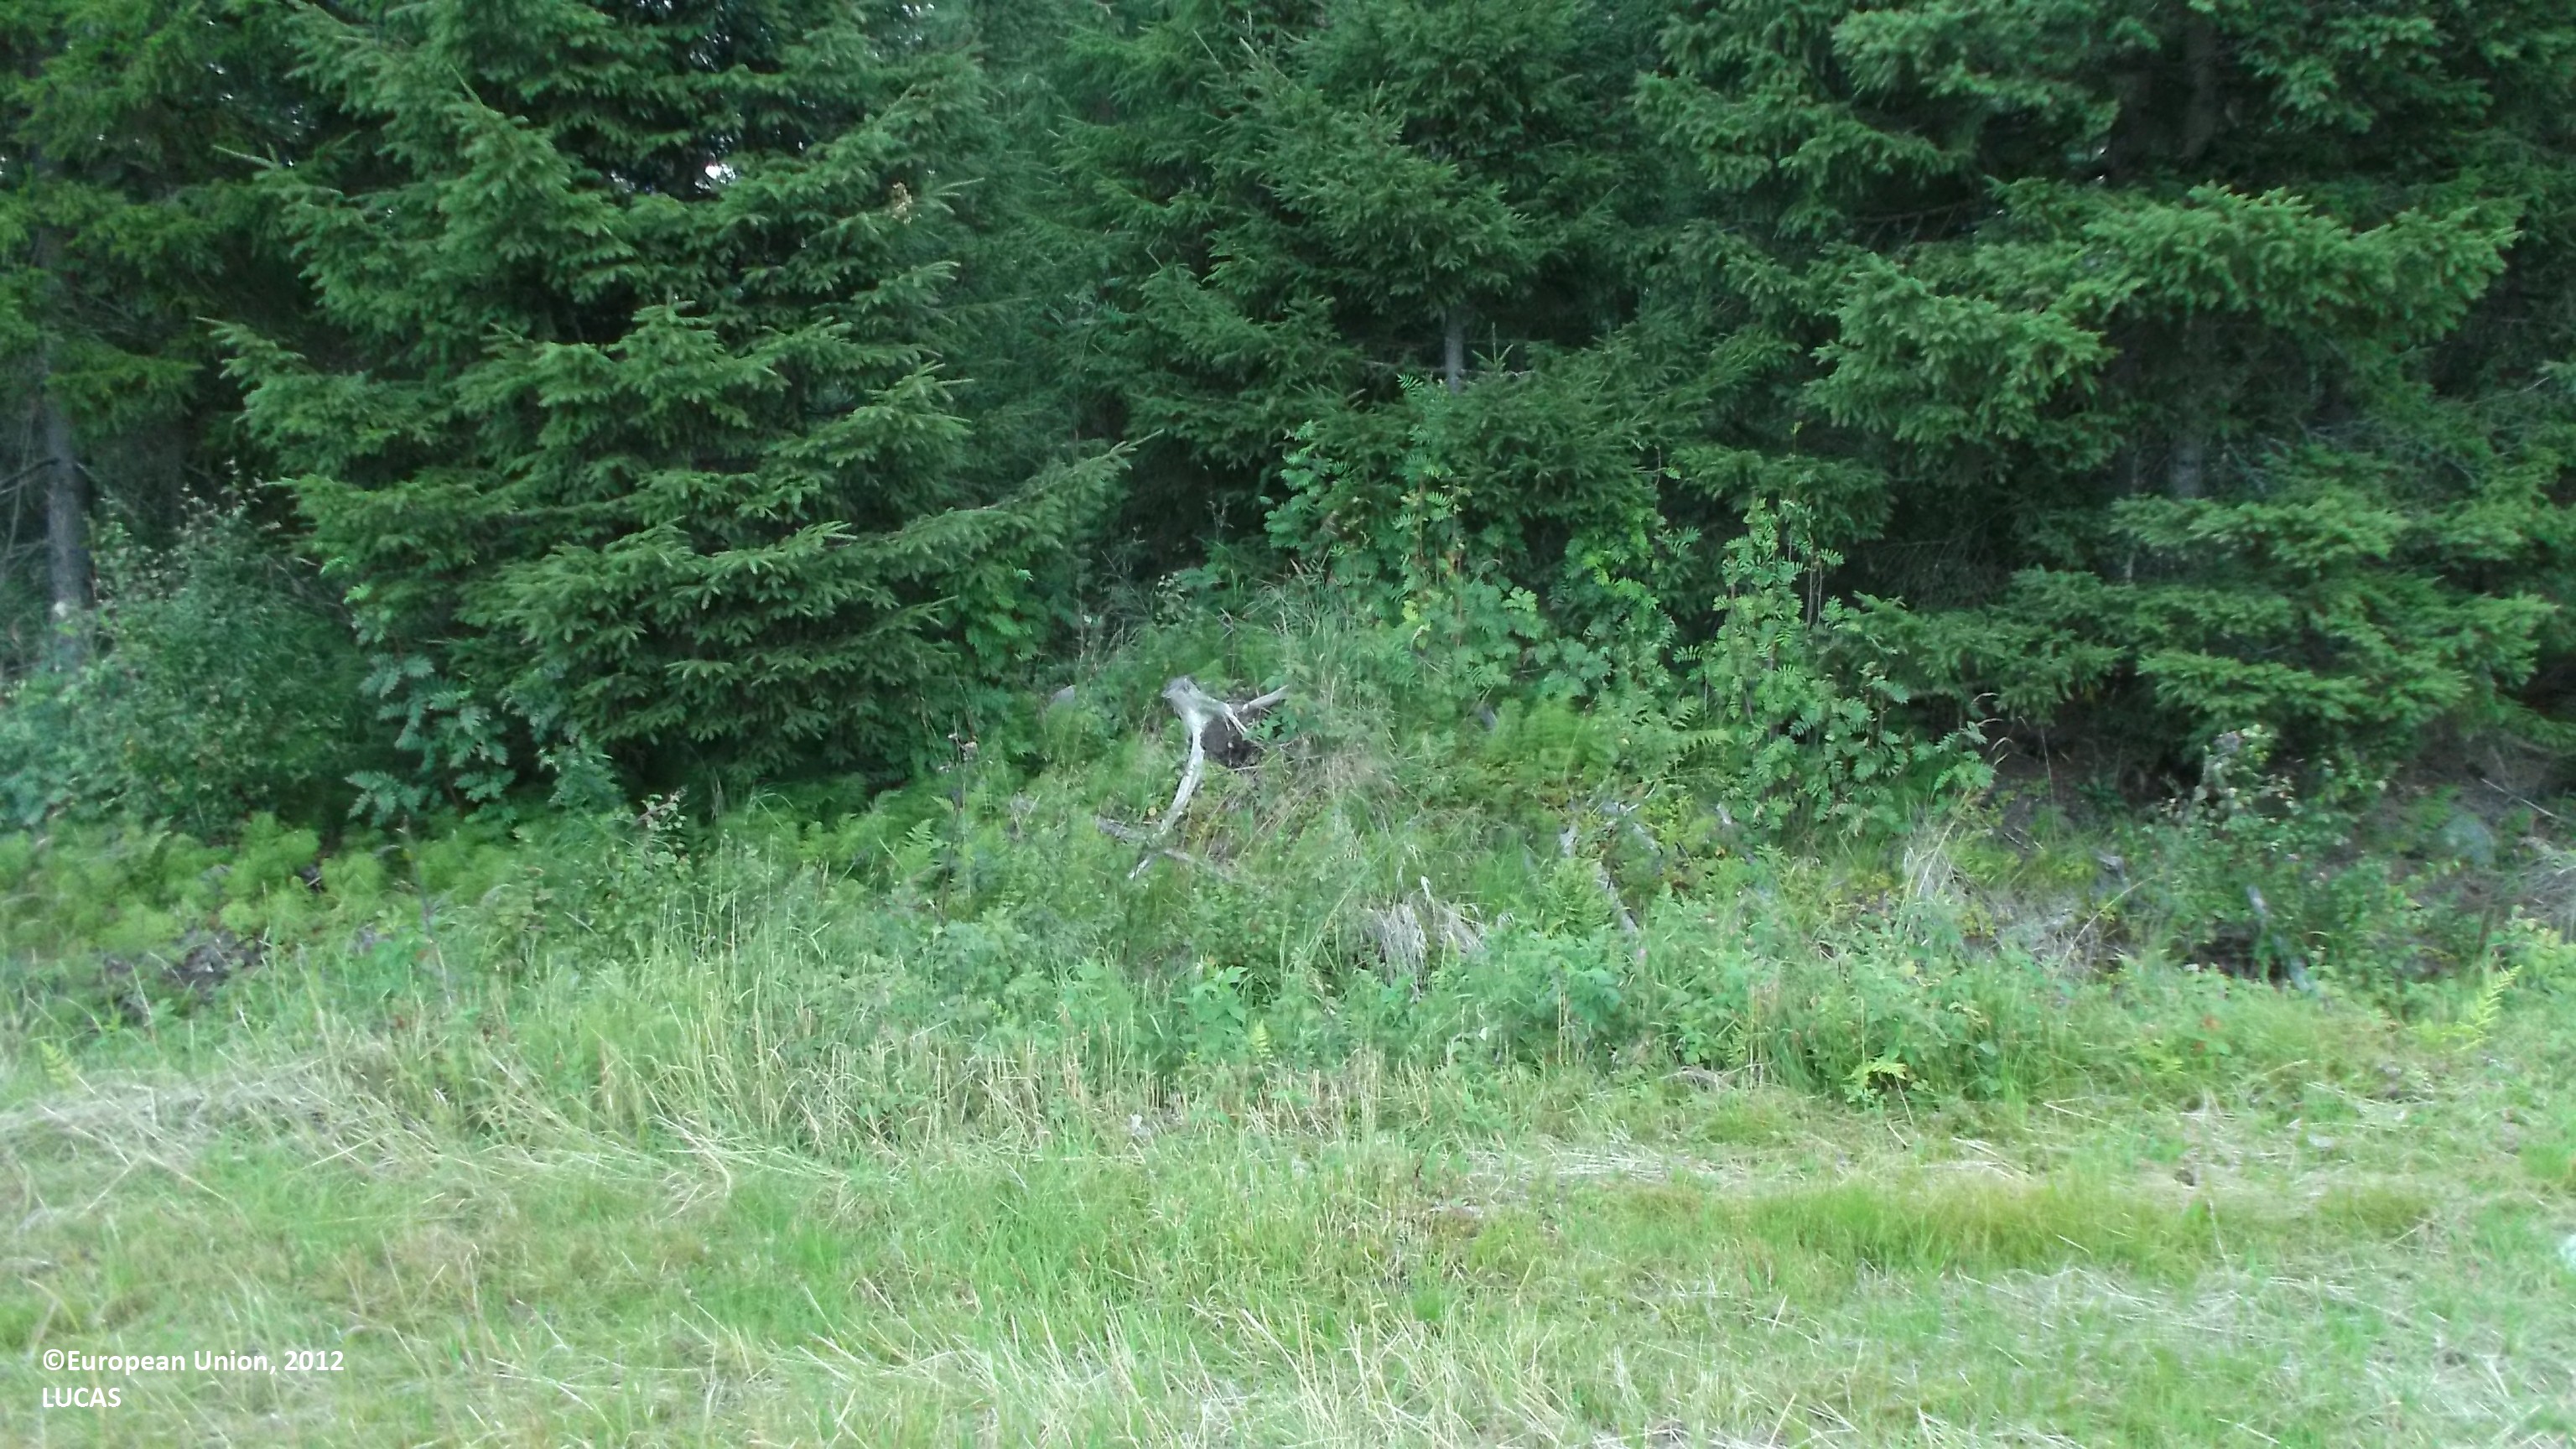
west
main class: Cropland
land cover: Temporary grasslands
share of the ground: > 75 %
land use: Agriculture (excluding fallow land and kitchen gardens)
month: July
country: FI
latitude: 63.6774
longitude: 23.2145
